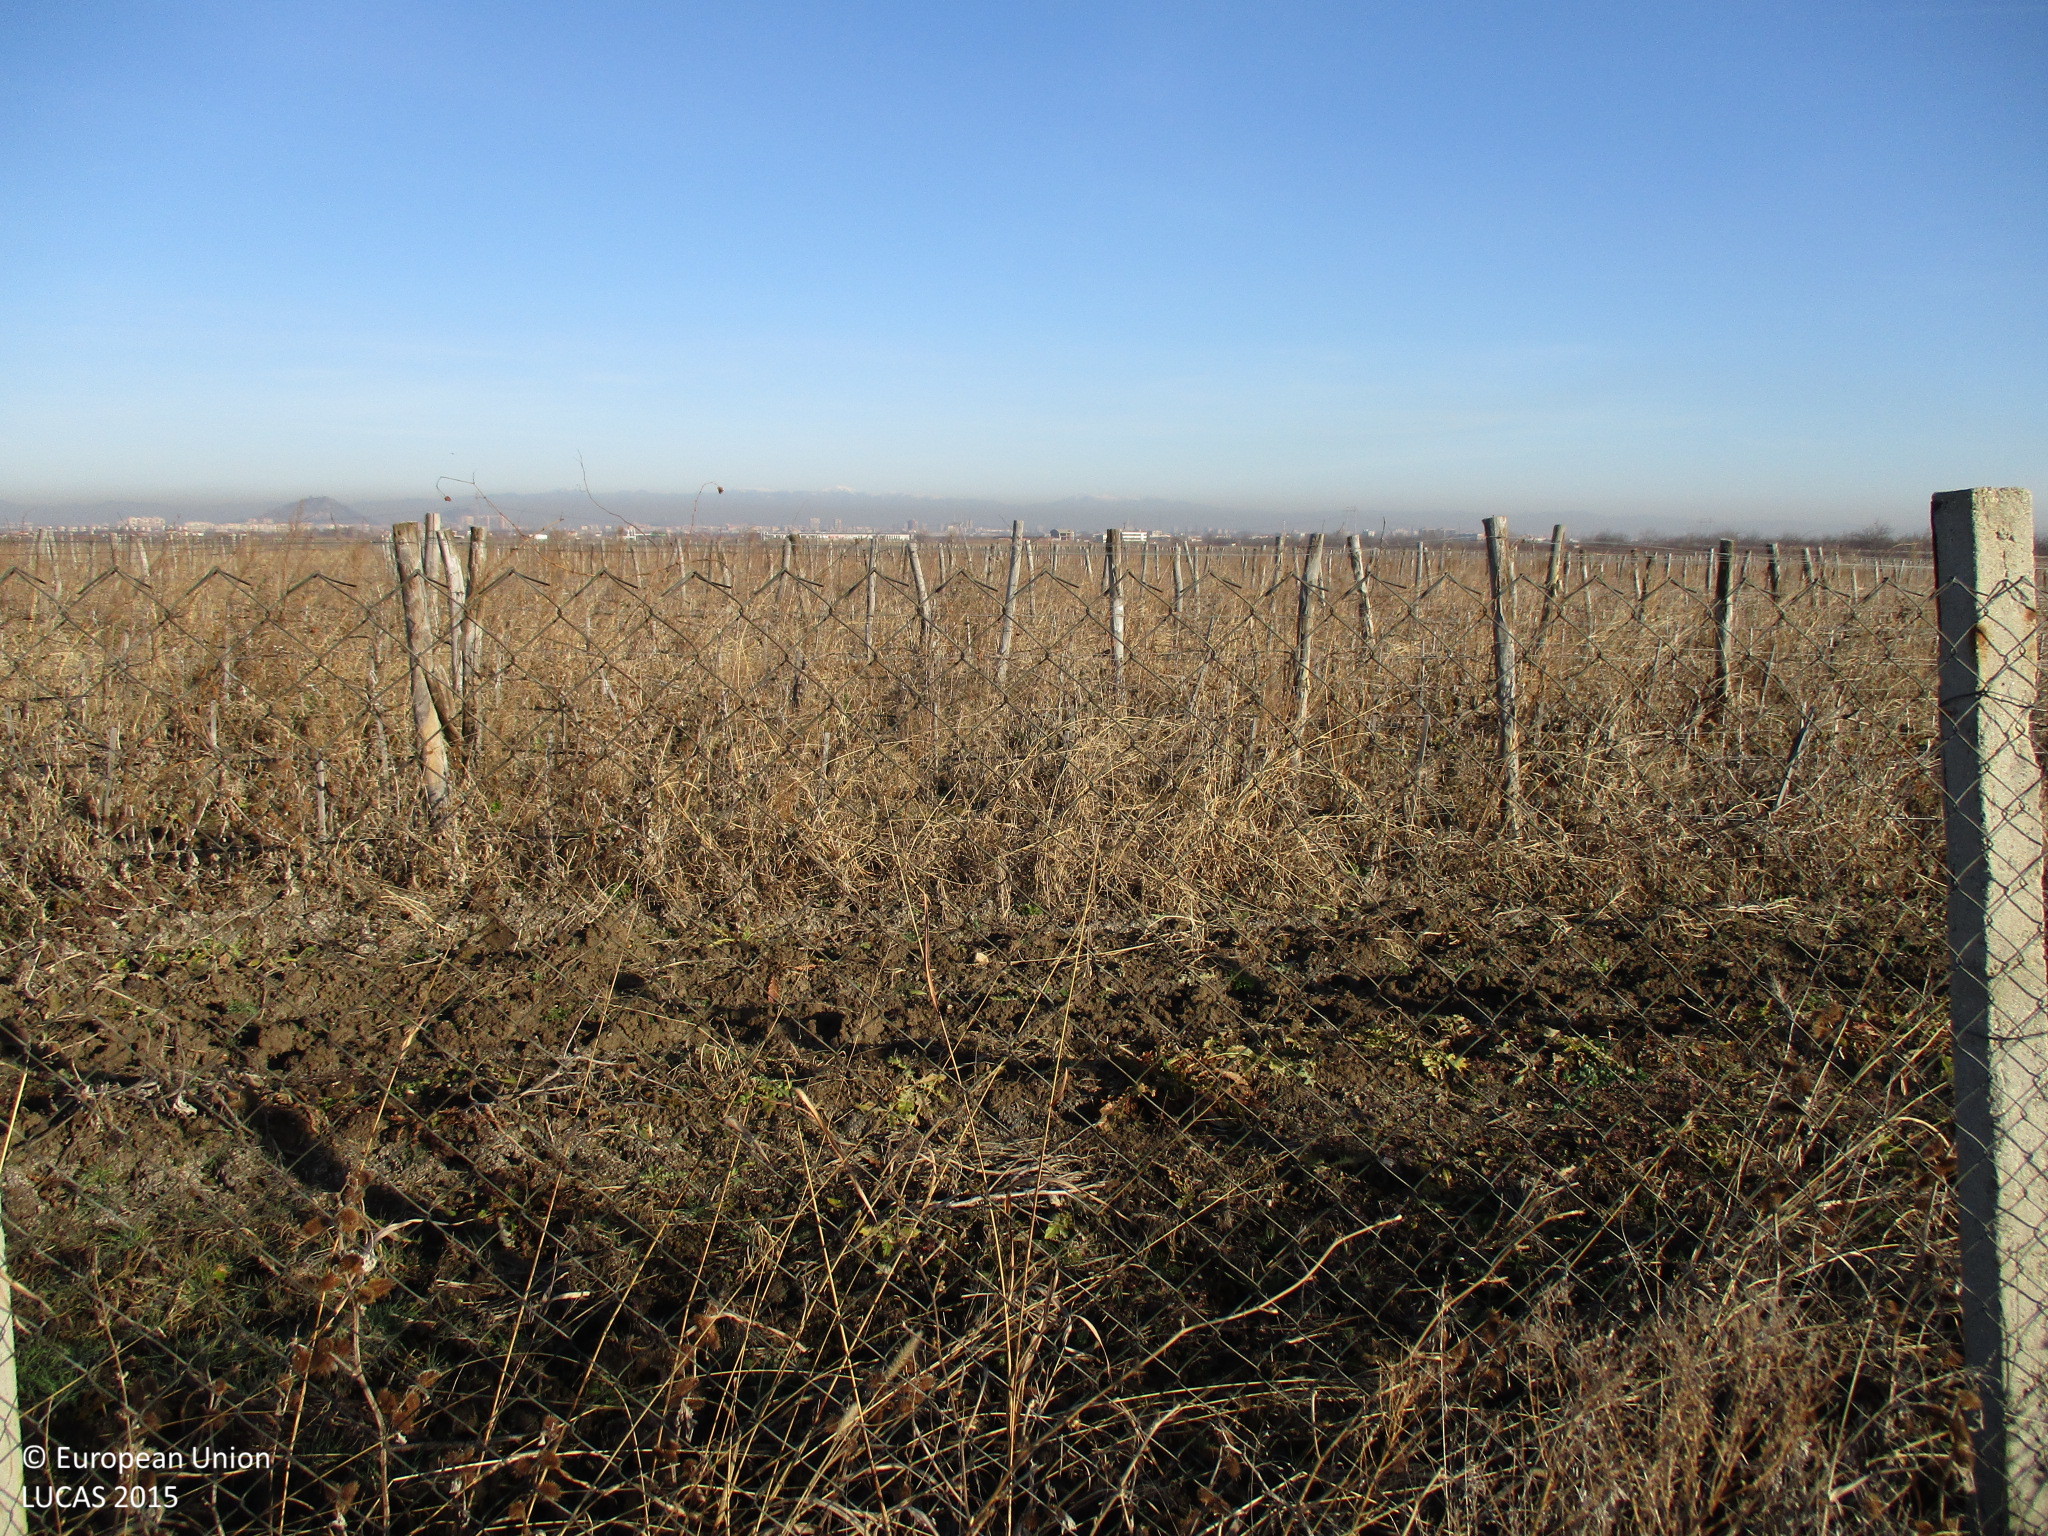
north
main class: Cropland
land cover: Vineyards
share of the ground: 25 - 50 %
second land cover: Spontaneously vegetated surfaces
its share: 25 - 50 %
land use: Agriculture (excluding fallow land and kitchen gardens)
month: December
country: BG
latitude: 42.0823
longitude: 24.7379
